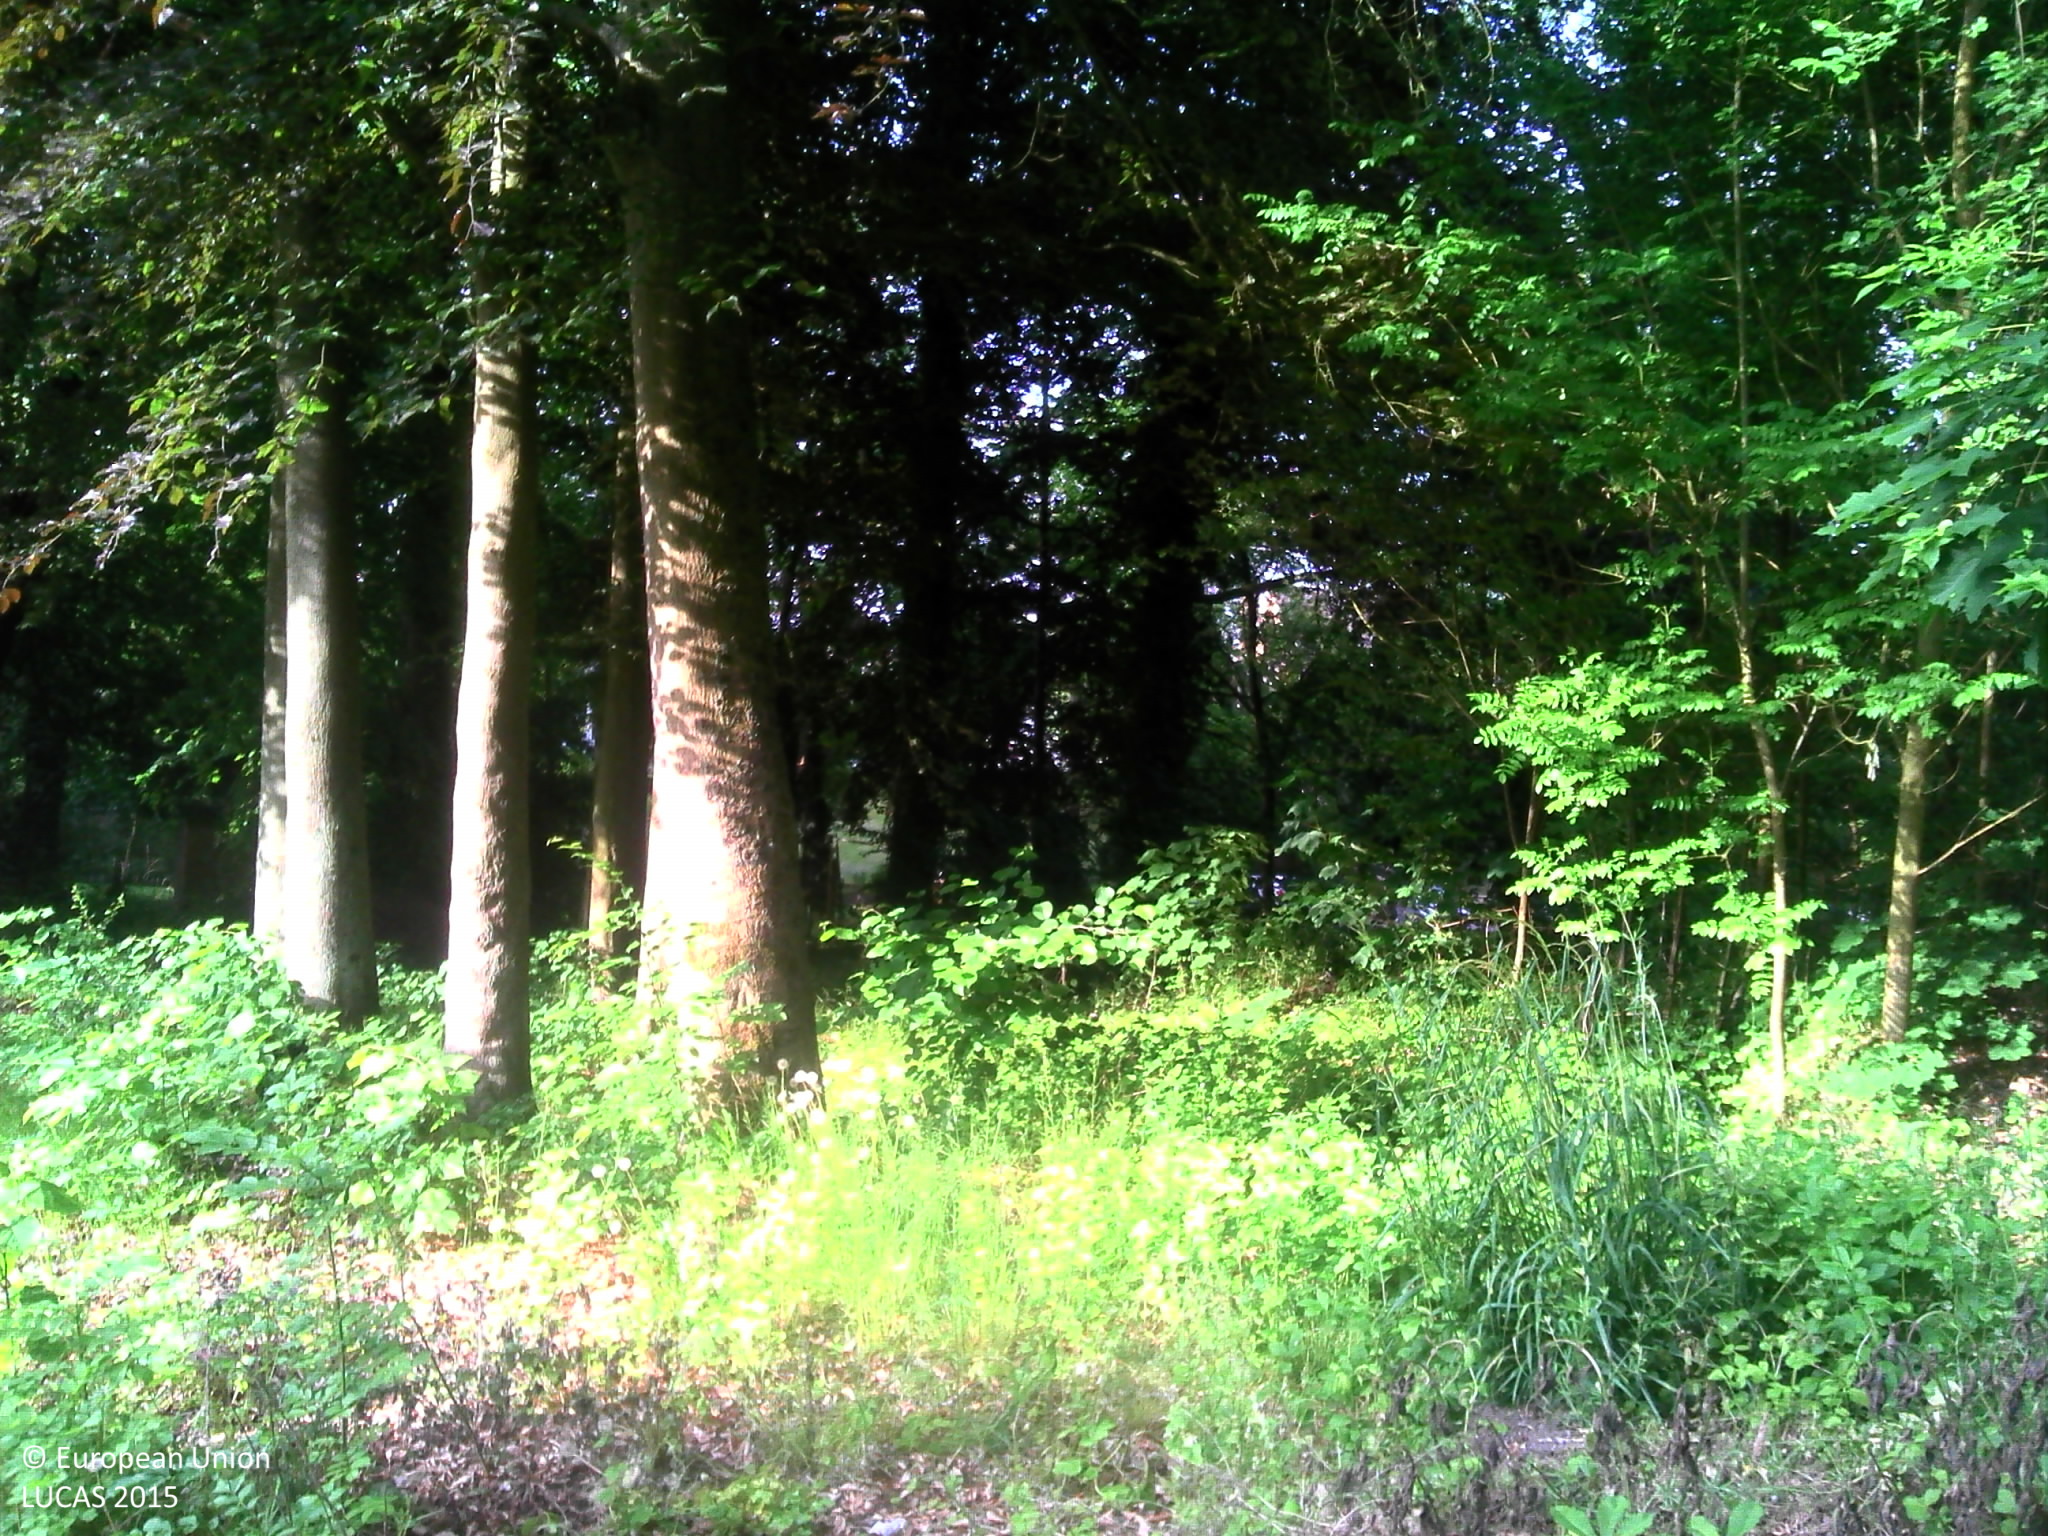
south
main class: Grassland
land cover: Spontaneously vegetated surfaces
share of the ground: > 75 %
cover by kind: herbaceous plants 80 %, unconsolidated bare surface 20 %
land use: Semi-natural and natural areas not in use
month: May
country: BE
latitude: 50.4479
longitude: 4.8848
